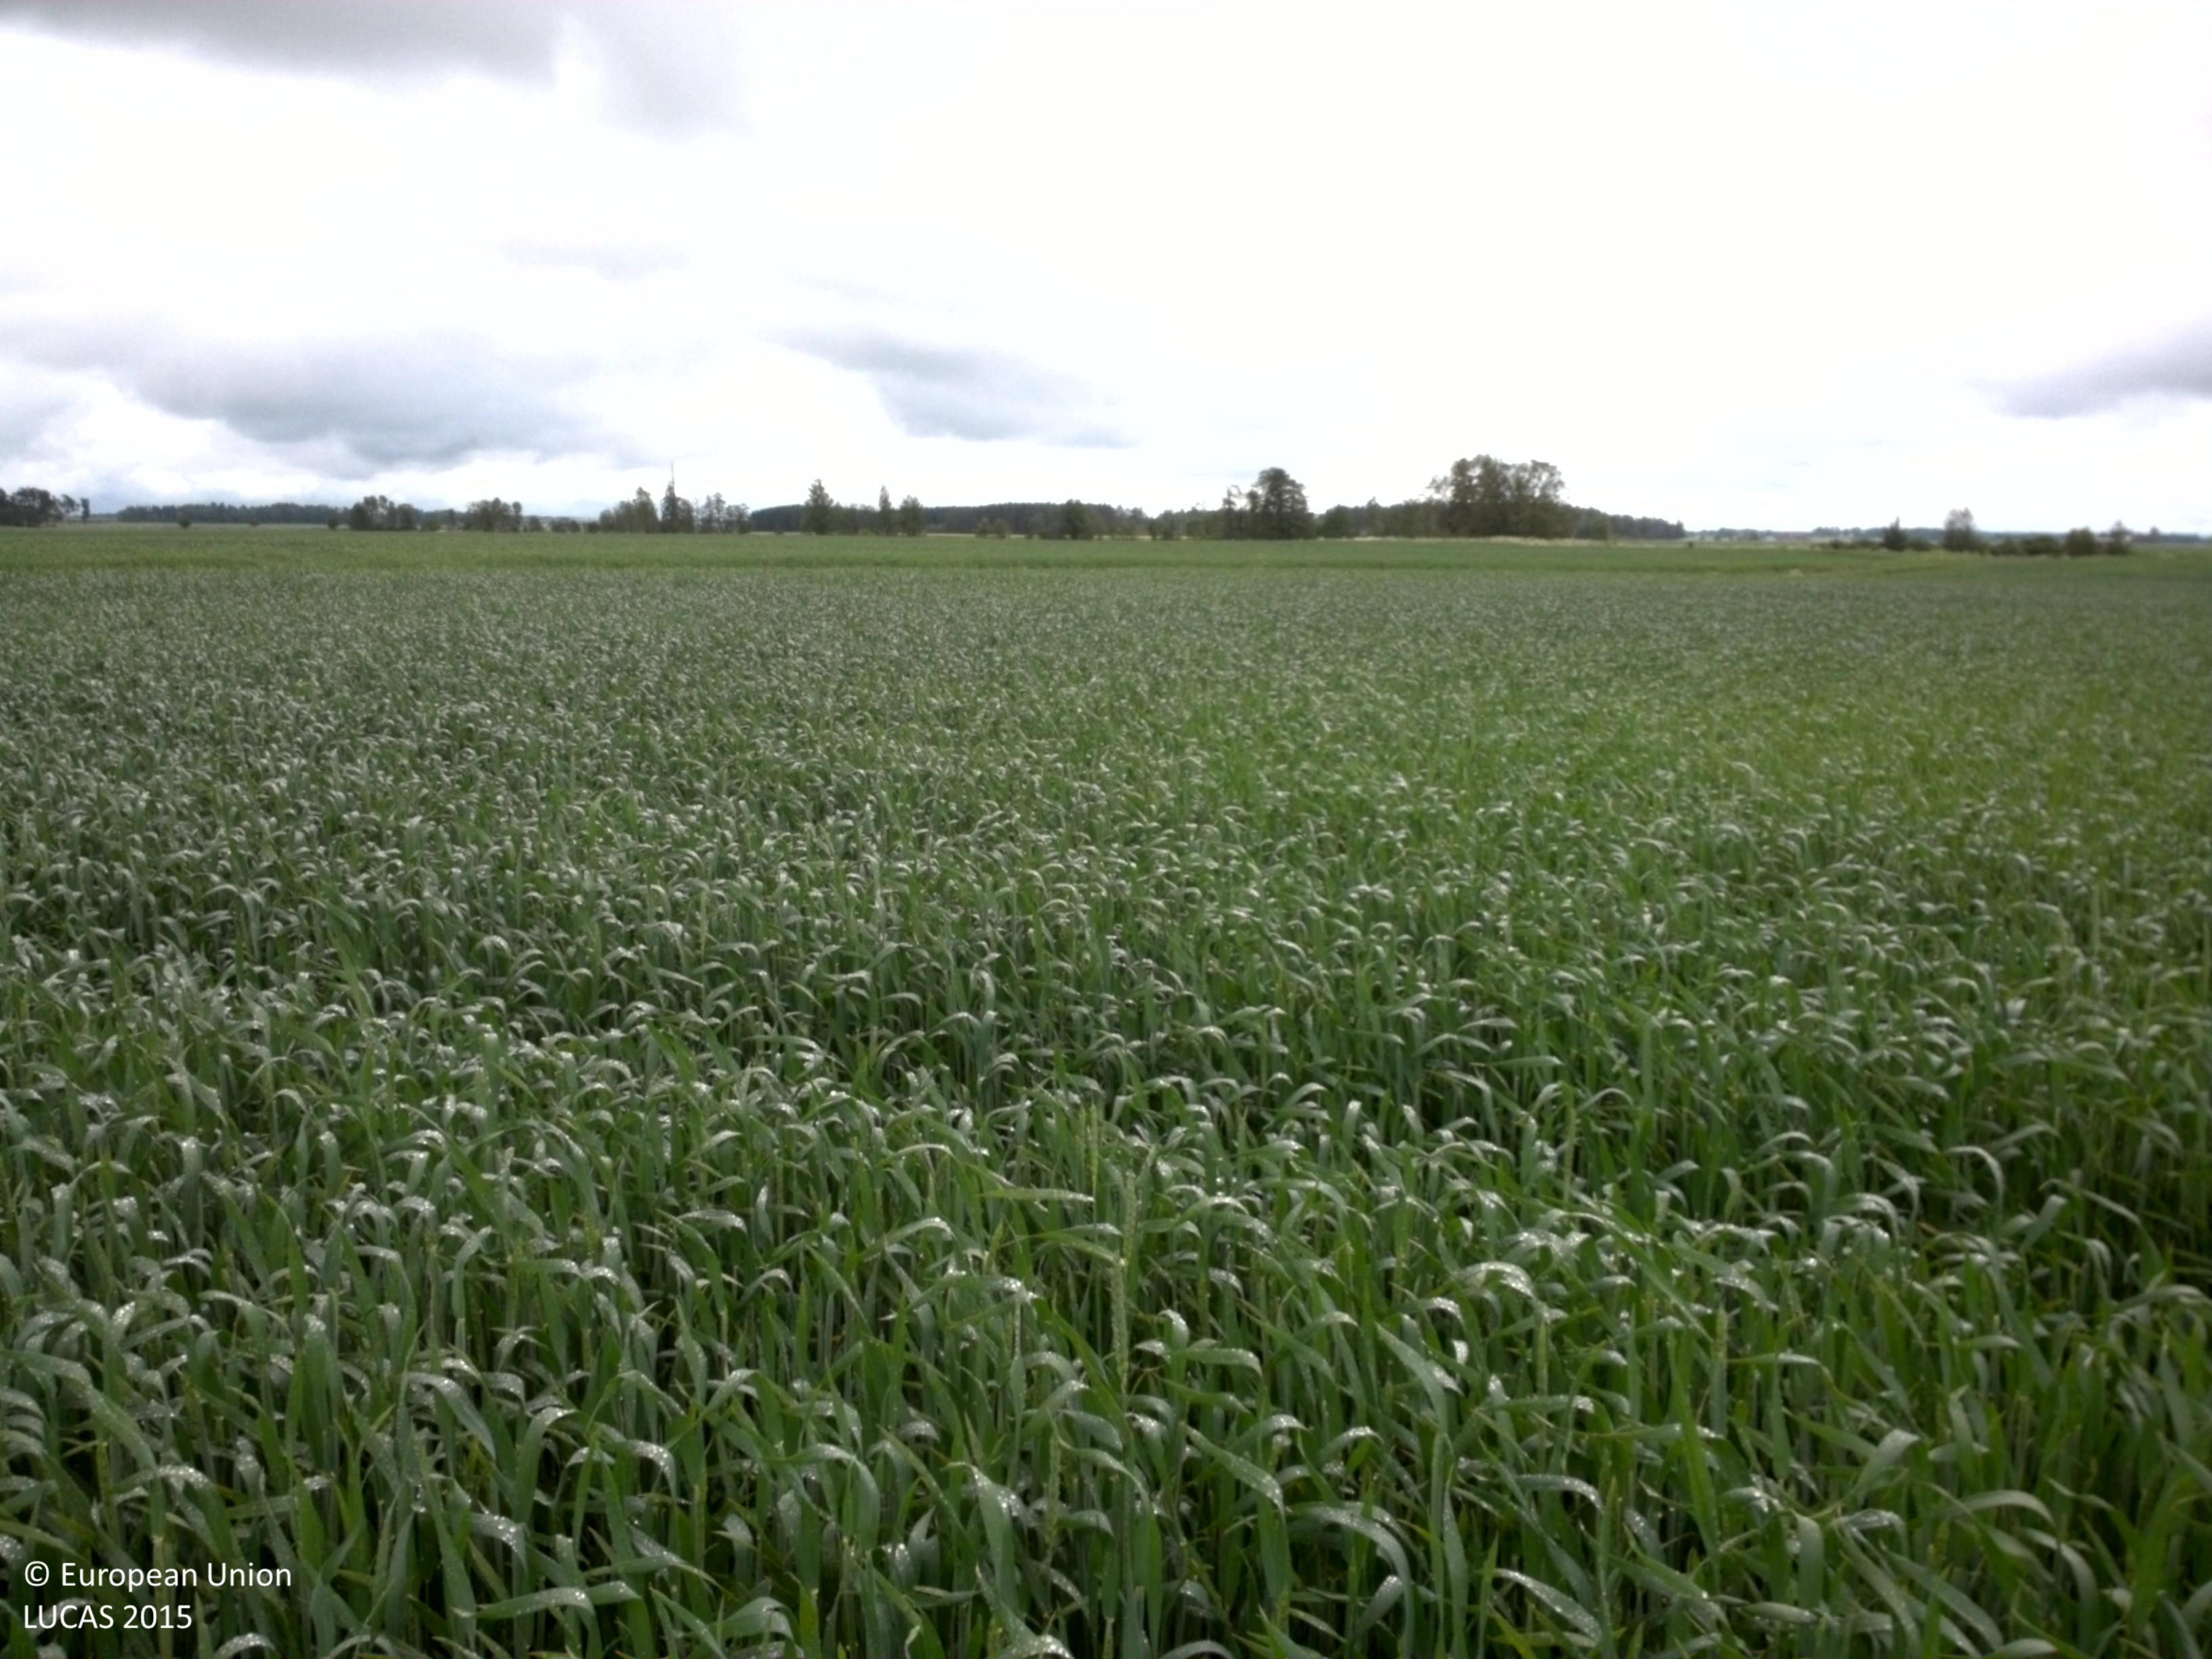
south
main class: Cropland
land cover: Common wheat
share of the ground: > 75 %
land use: Agriculture (excluding fallow land and kitchen gardens)
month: June
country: SE
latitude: 58.4401
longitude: 15.2873
